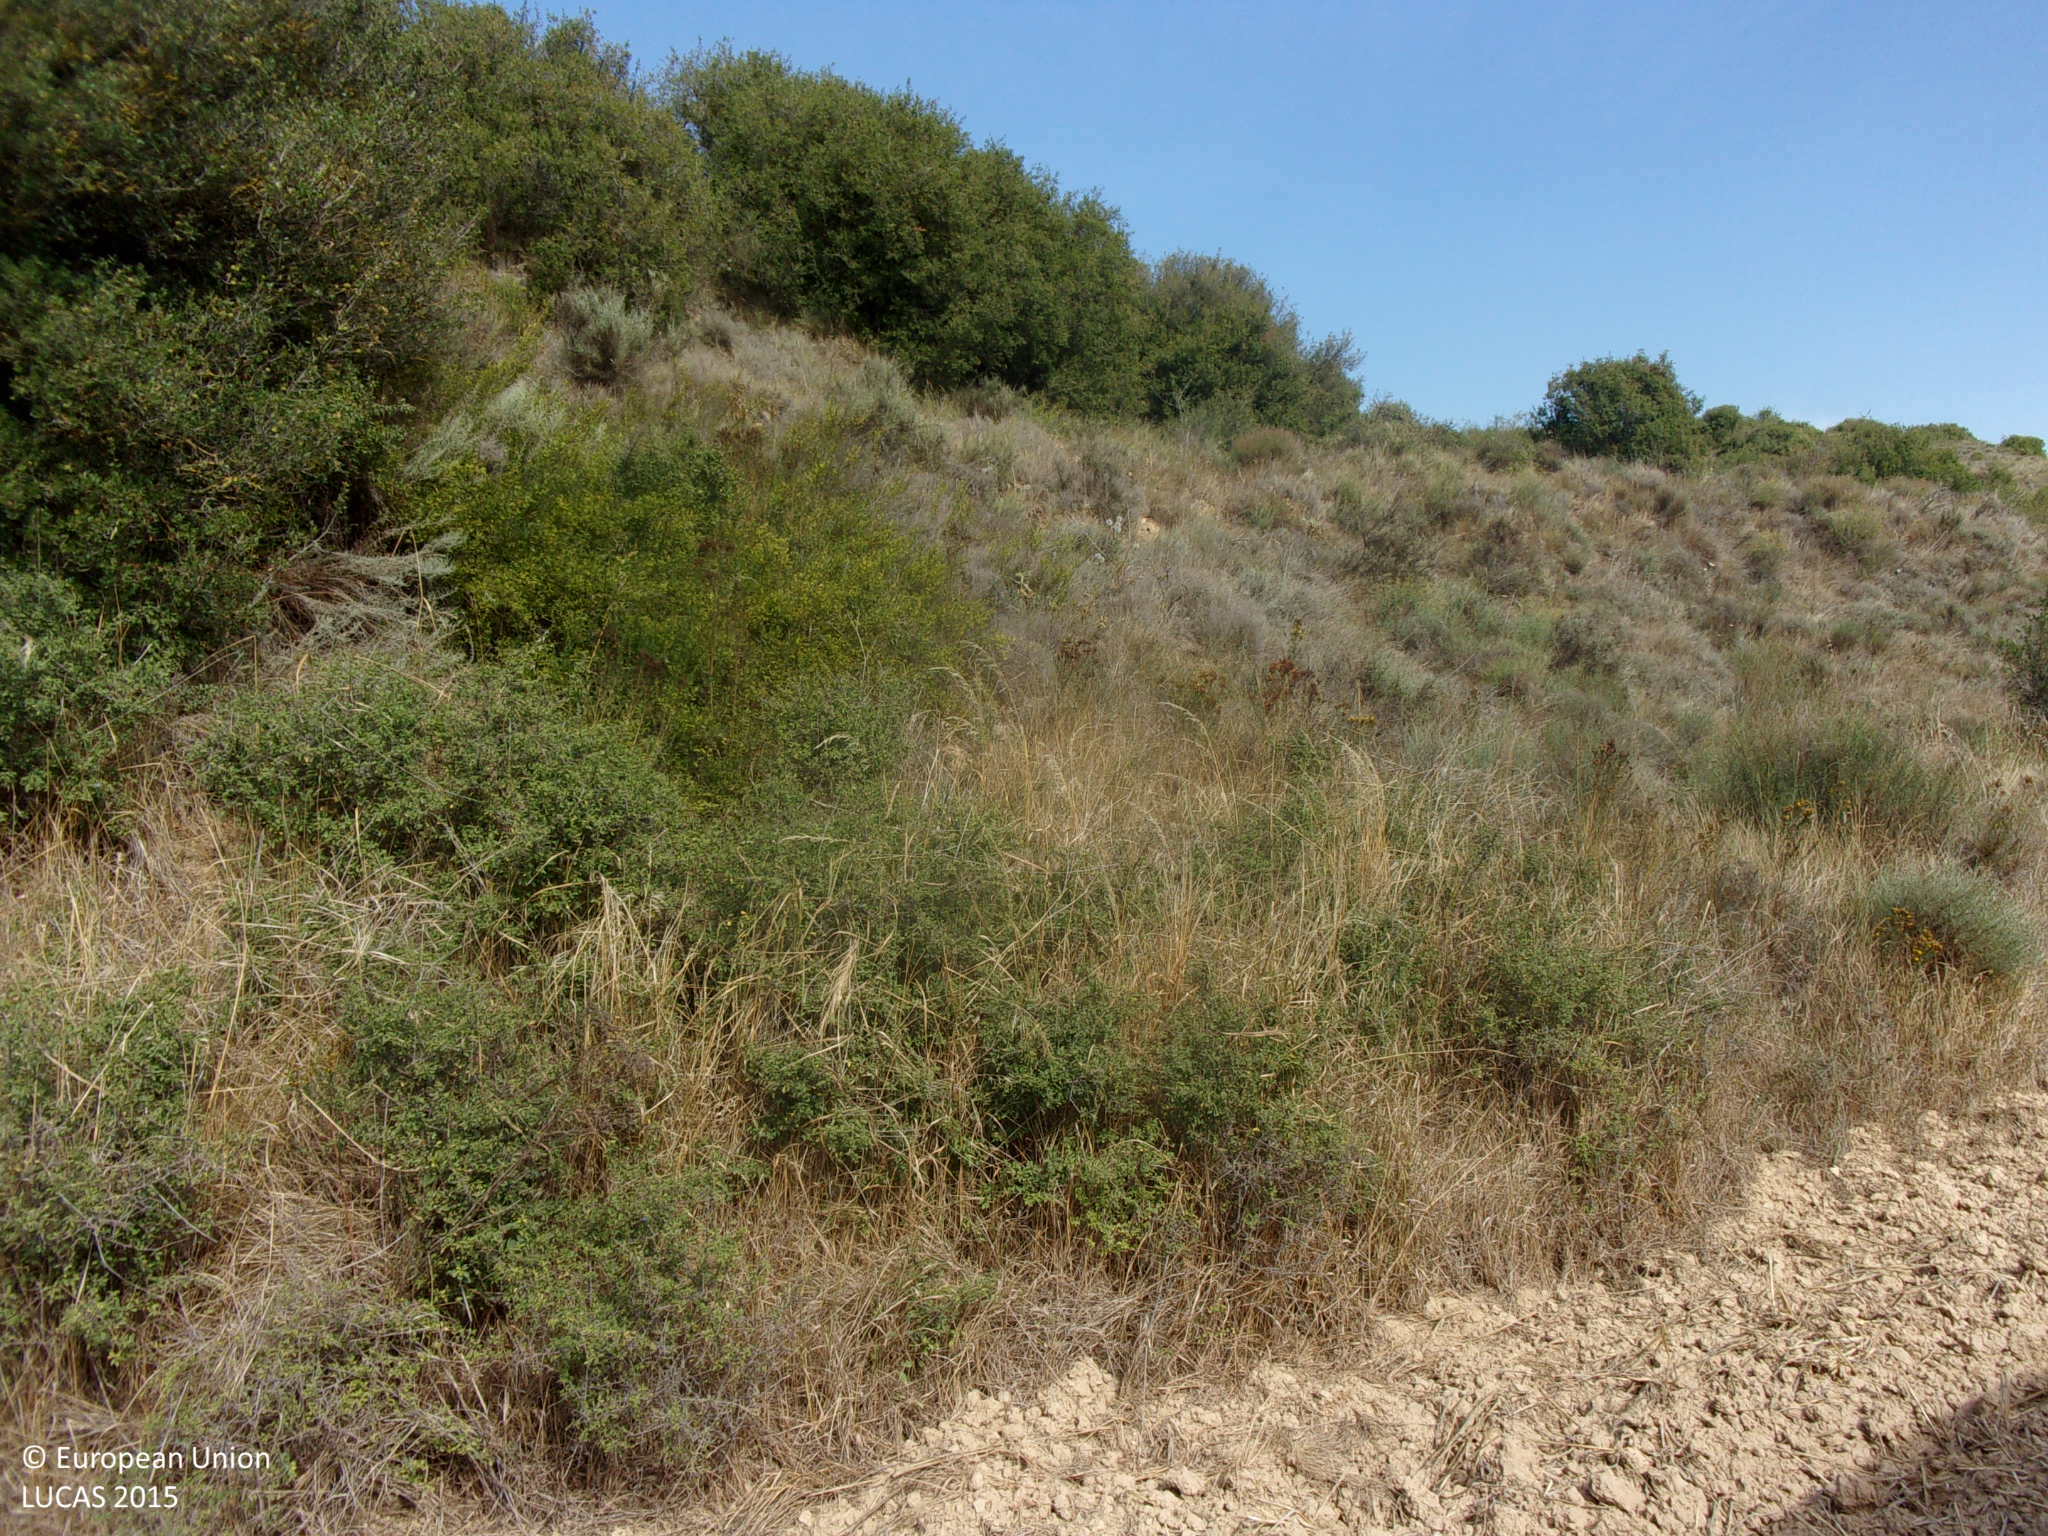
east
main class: Cropland
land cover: Common wheat
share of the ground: < 10 %
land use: Agriculture (excluding fallow land and kitchen gardens)
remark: Harvested field
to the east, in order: Common wheat; Shrubland without tree cover; Common wheat; Shruby margins; Lucerne; Electric lines; Shruby margins; Lucerne
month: August
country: ES
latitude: 42.5205
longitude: -1.2189
